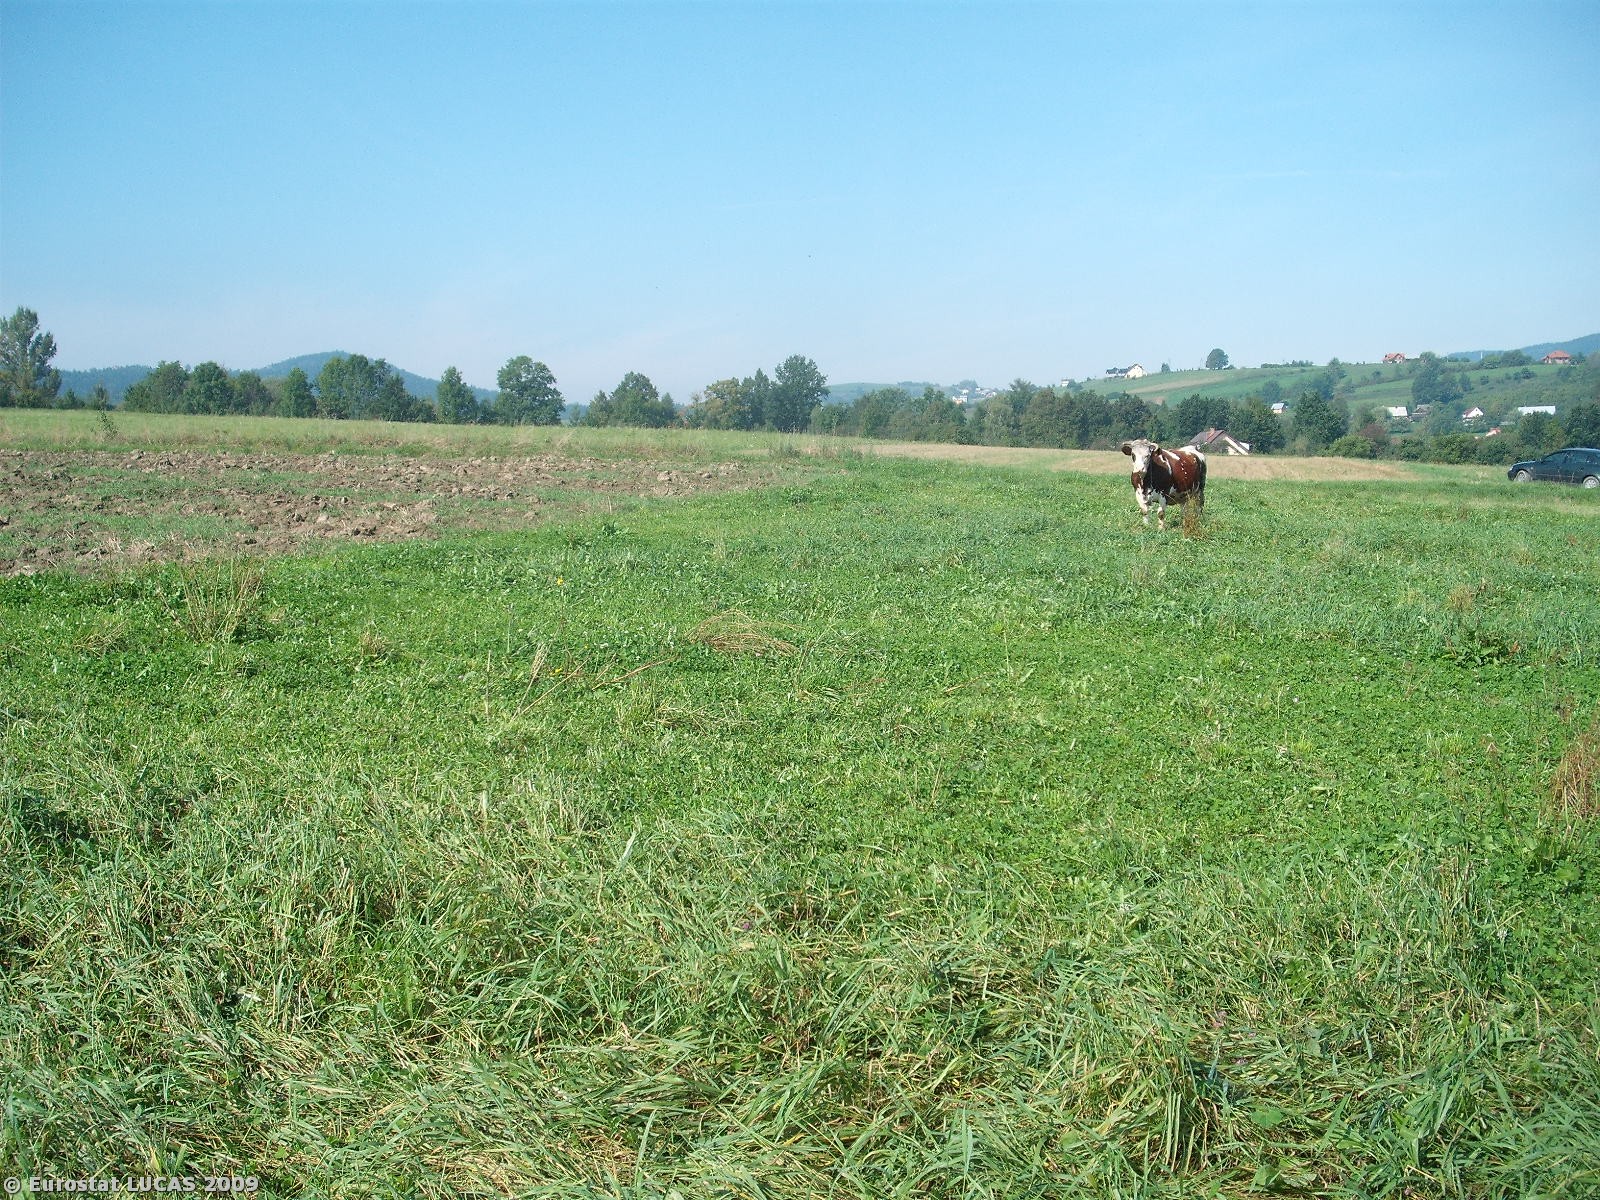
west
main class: Cropland
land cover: Clovers
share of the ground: > 75 %
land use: Agriculture (excluding fallow land and kitchen gardens)
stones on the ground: < 10 %
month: September
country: PL
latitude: 49.6772
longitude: 20.5282
